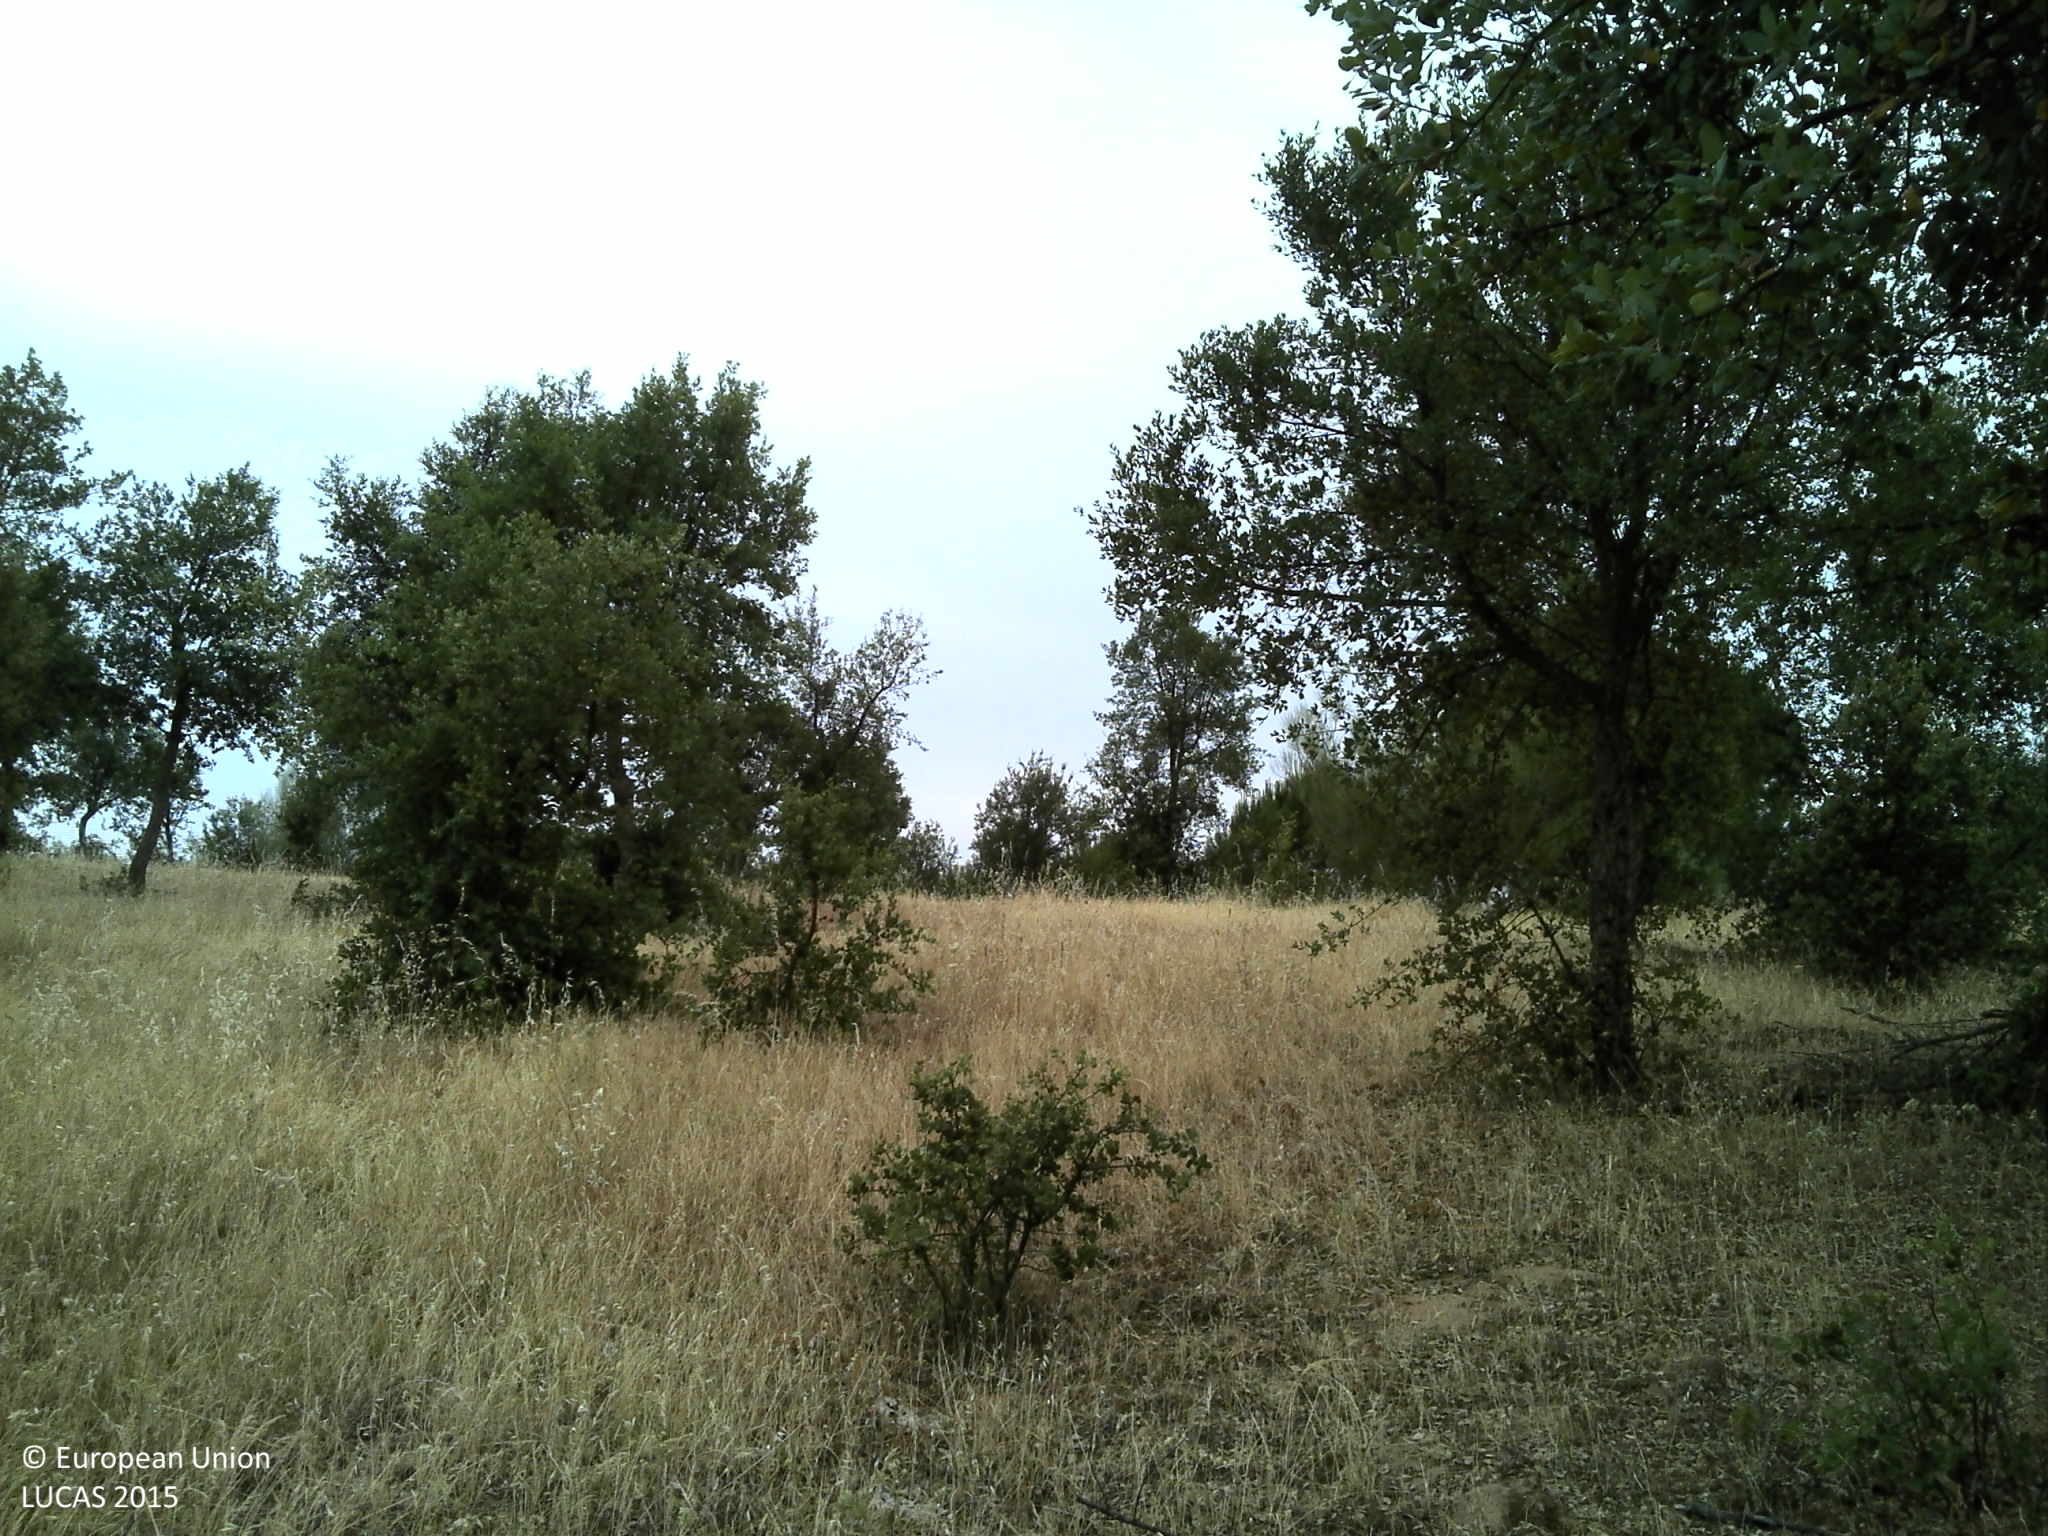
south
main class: Woodland
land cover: Broadleaved woodland
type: broadleaved evergreen forest
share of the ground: 25 - 50 %
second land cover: Grassland without tree/shrub cover
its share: 25 - 50 %
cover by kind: unconsolidated bare surface 40 %, broadleaved forest trees 30 %, herbaceous plants 30 %
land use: Forestry
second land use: Agriculture (excluding fallow land and kitchen gardens)
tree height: < 5 m
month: June
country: PT
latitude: 38.6452
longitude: -7.7893
